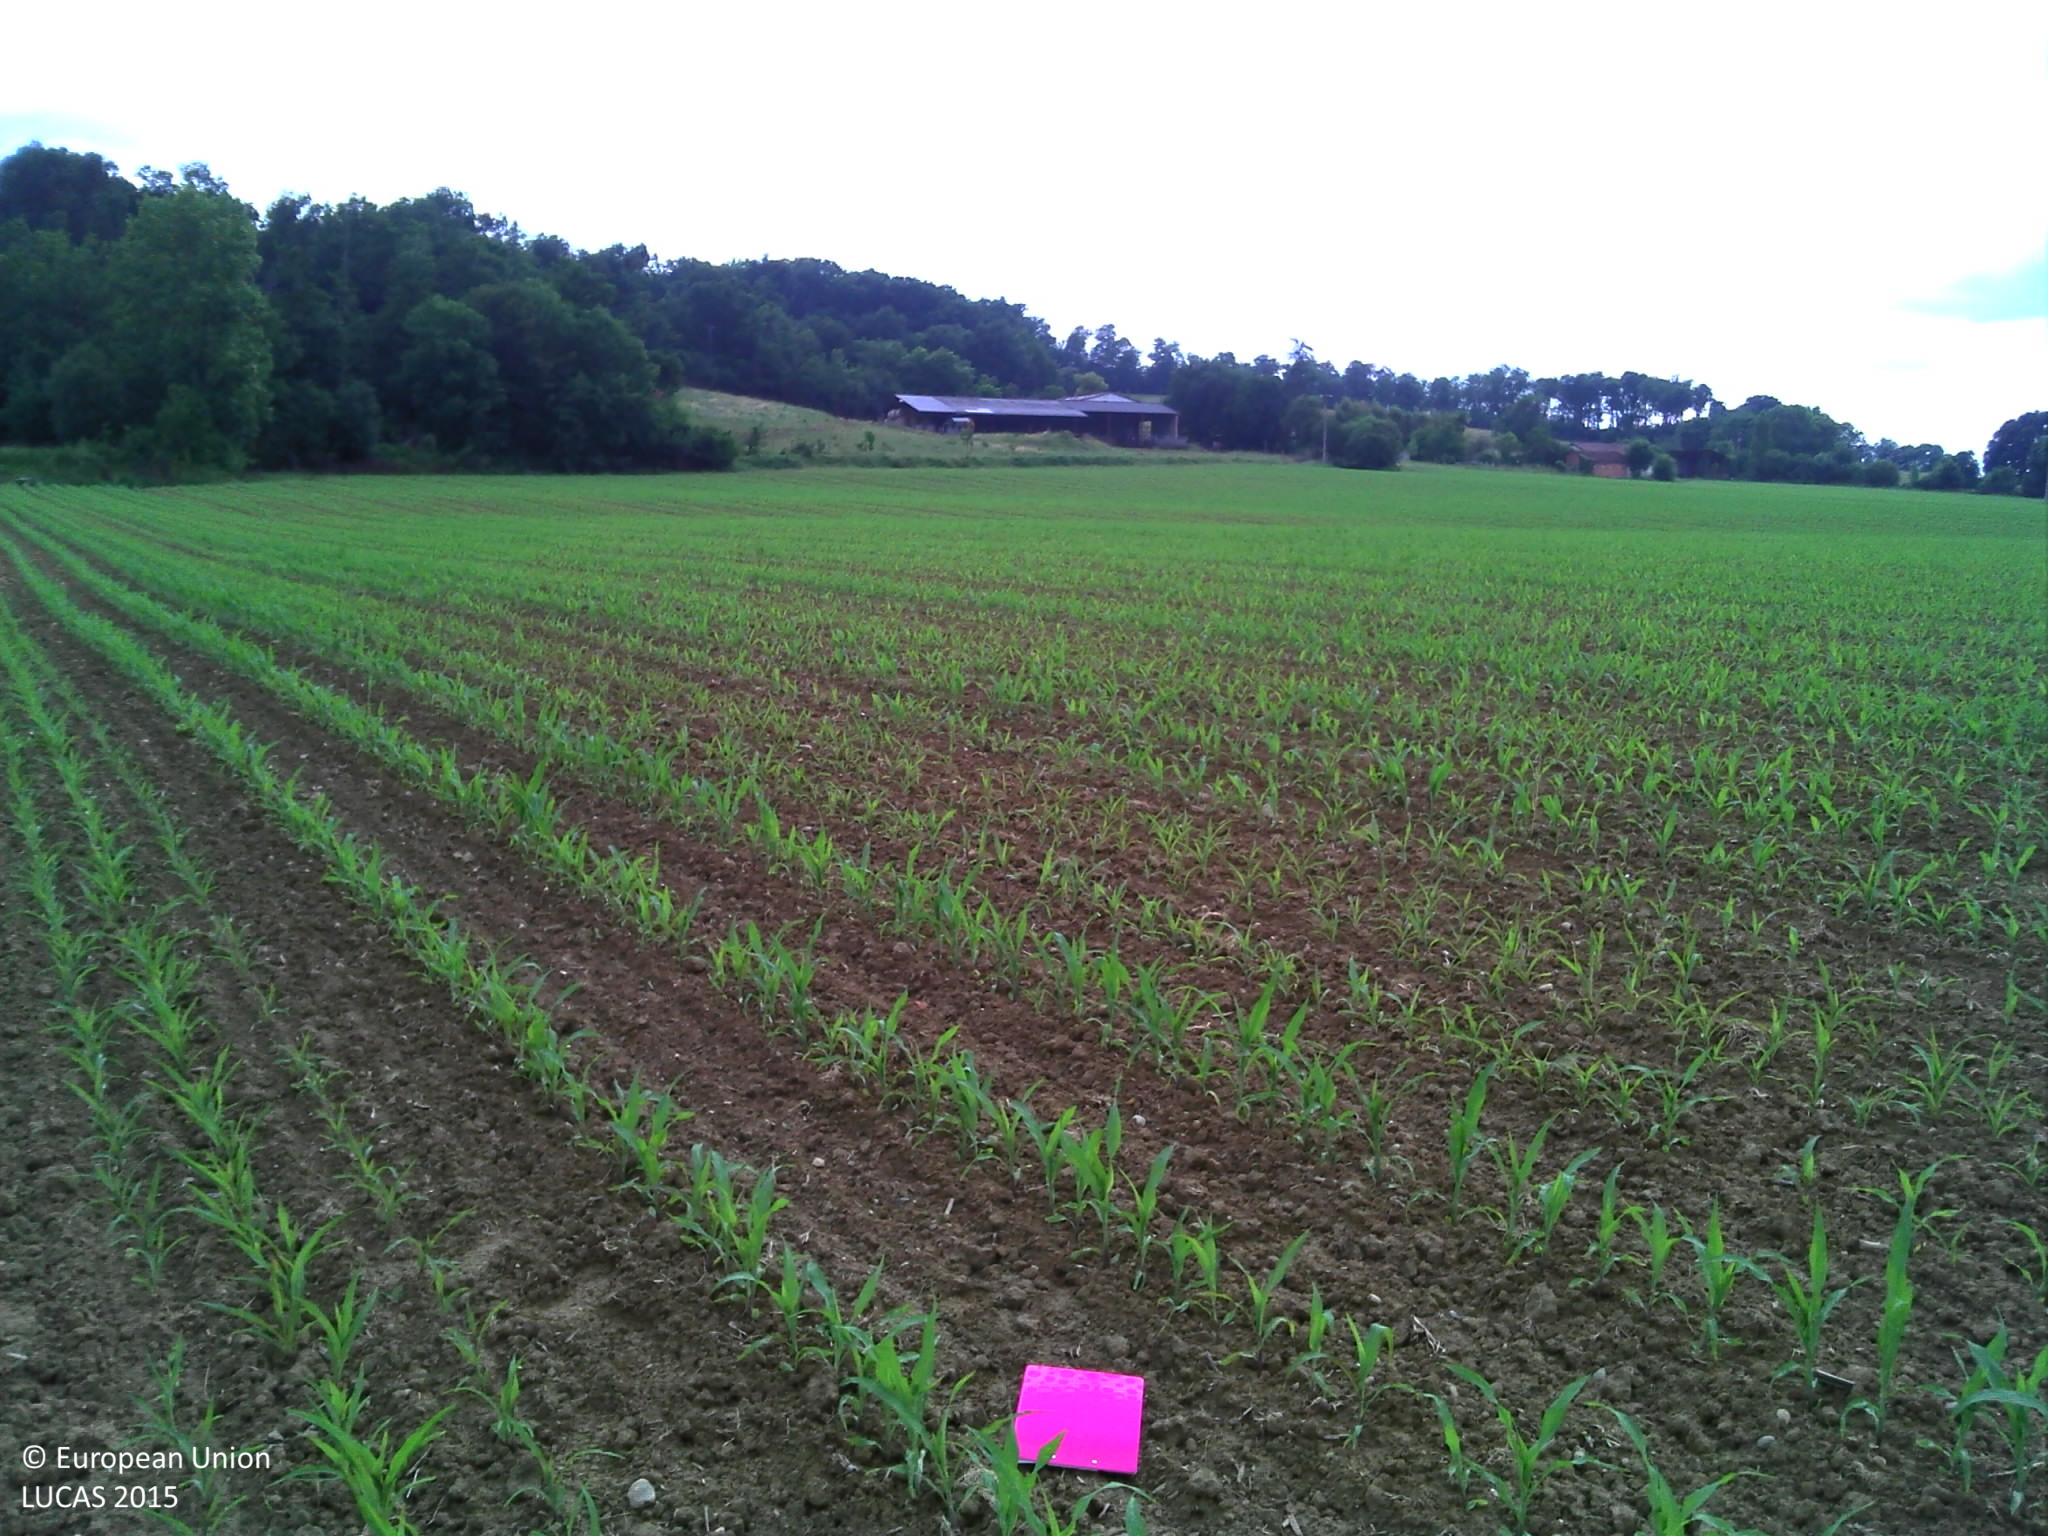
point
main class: Cropland
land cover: Maize
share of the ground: 10 - 25 %
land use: Agriculture (excluding fallow land and kitchen gardens)
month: June
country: FR
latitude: 43.6100
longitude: -0.2046
